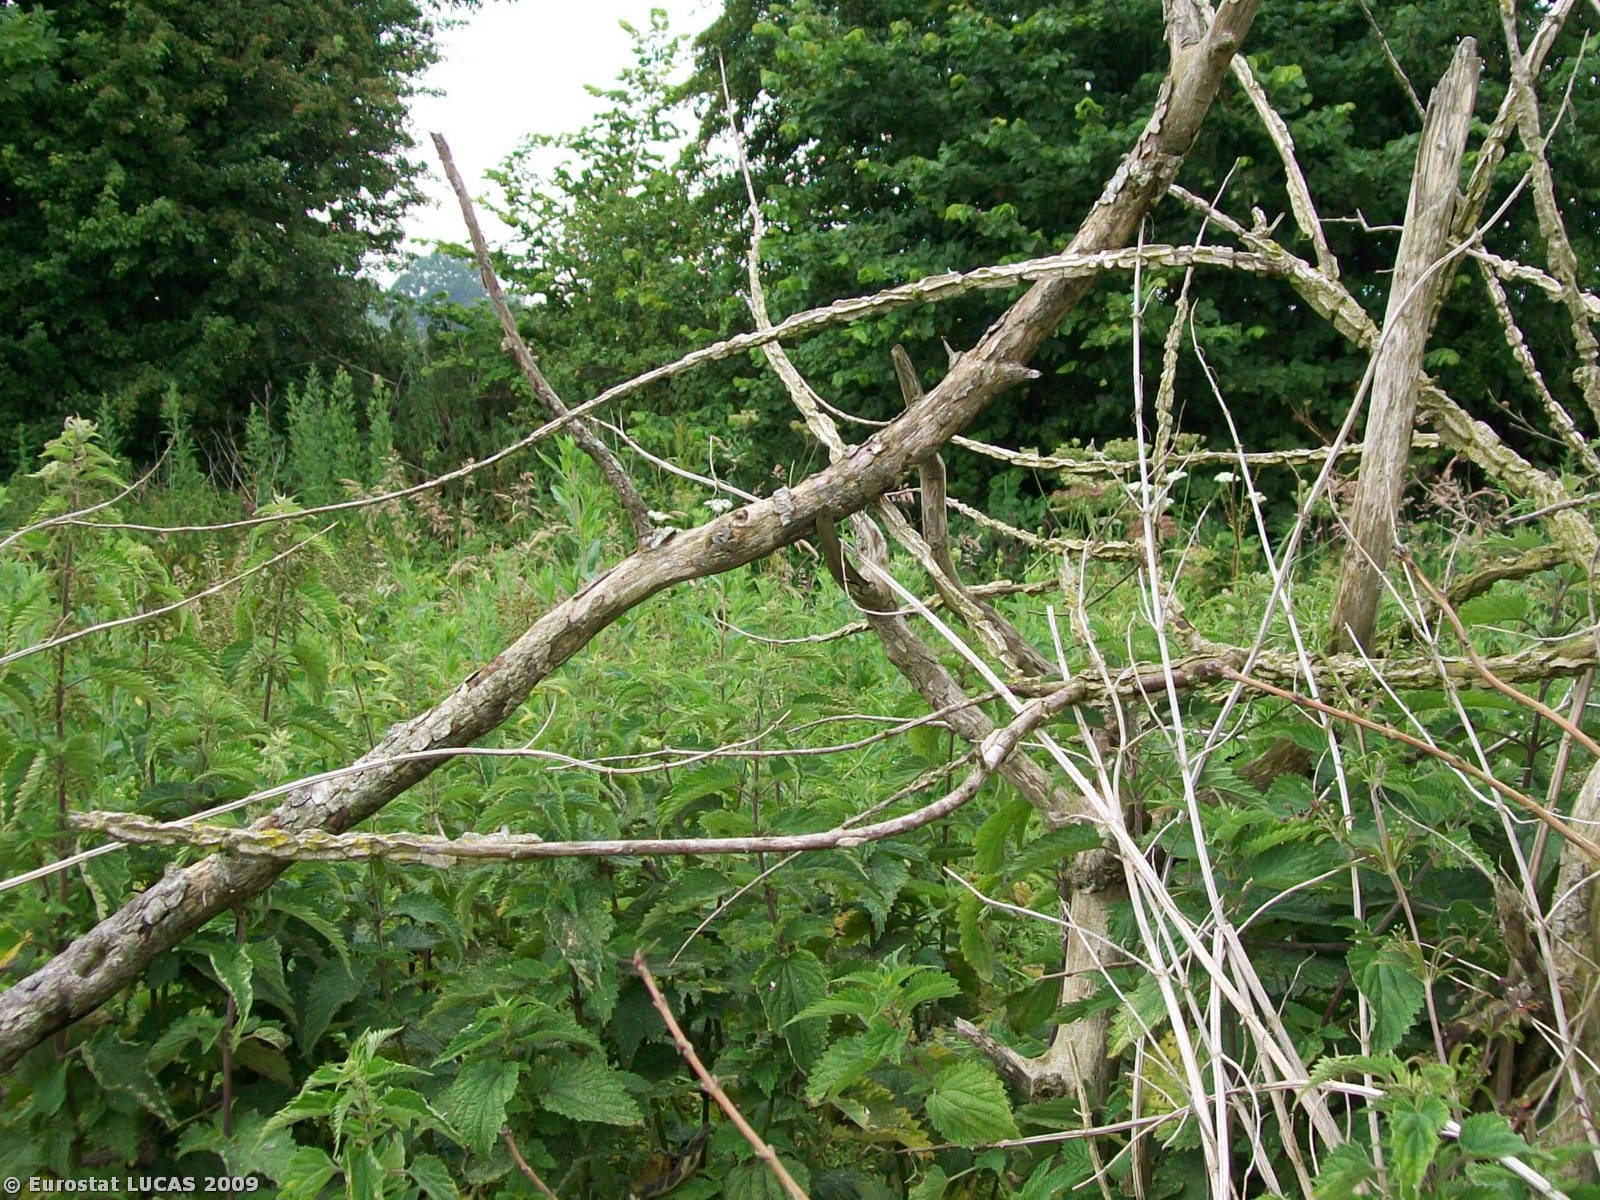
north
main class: Cropland
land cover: Barley
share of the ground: > 75 %
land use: Agriculture (excluding fallow land and kitchen gardens)
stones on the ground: < 10 %
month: June
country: GB
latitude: 51.2514
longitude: -2.2260
